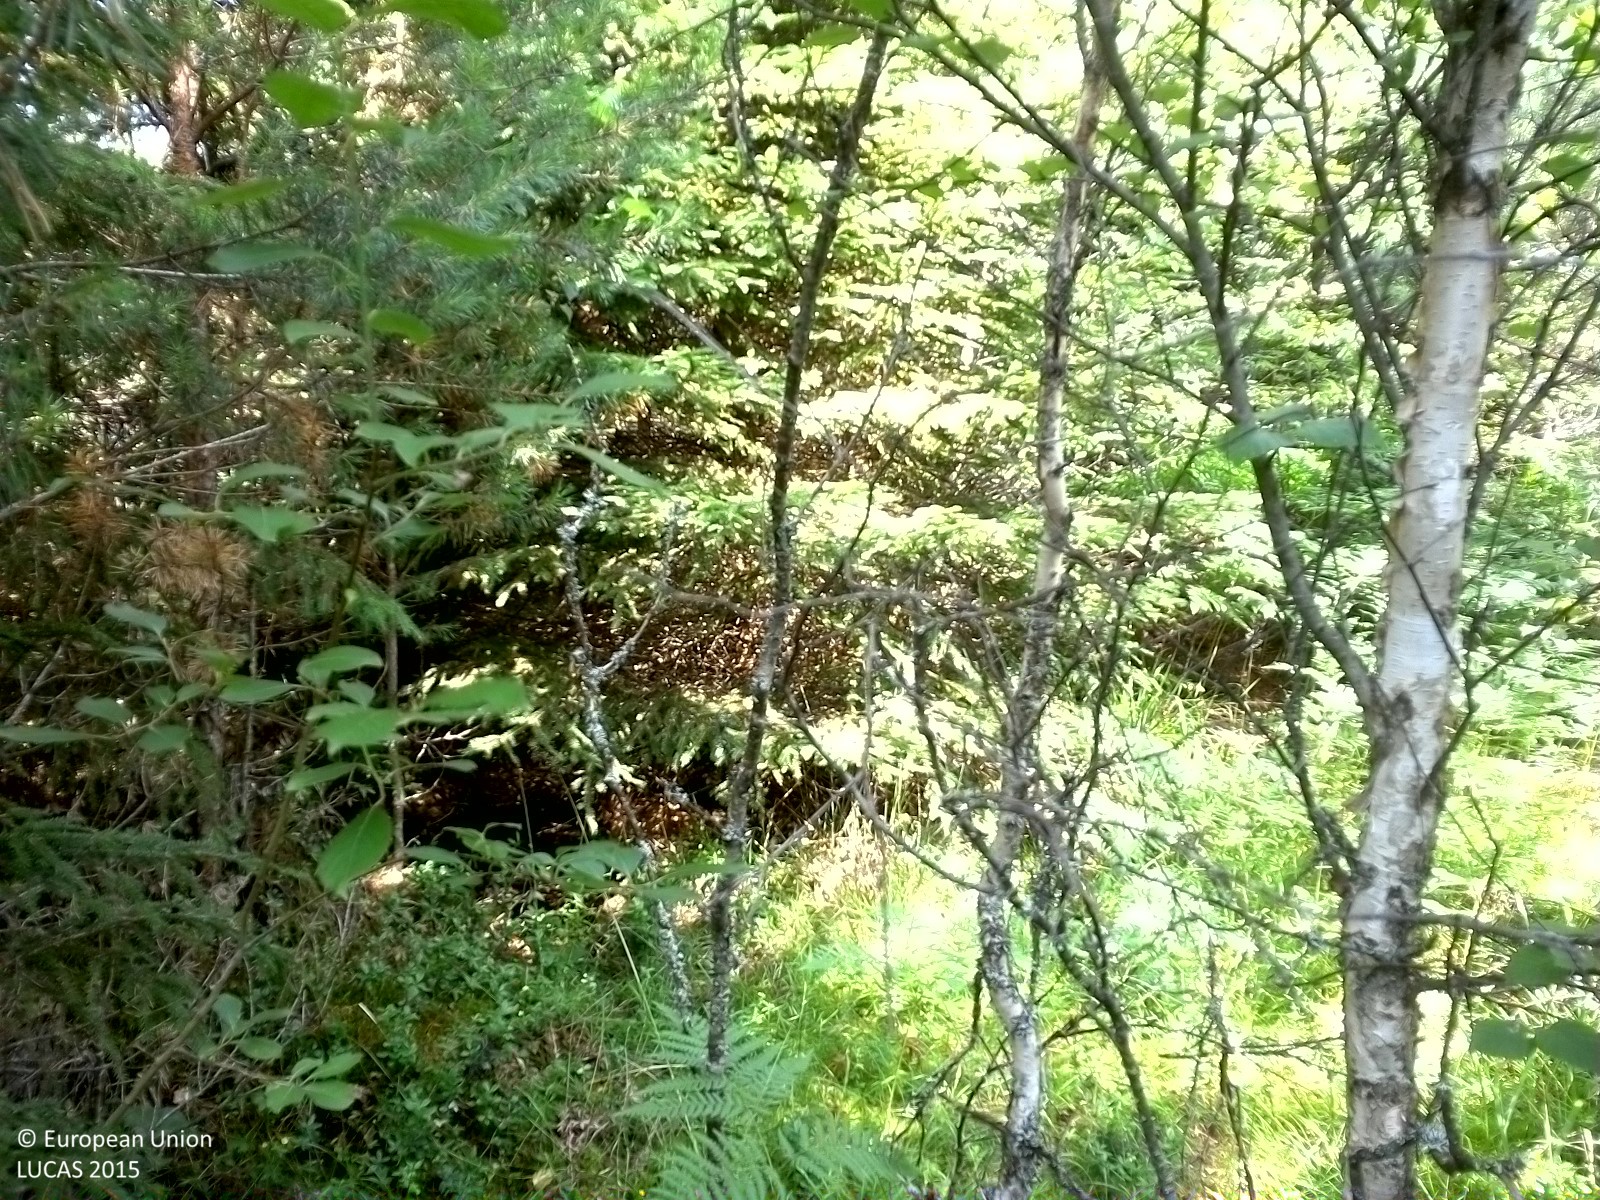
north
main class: Woodland
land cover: Other mixed woodland
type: boreal forest
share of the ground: > 75 %
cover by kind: coniferous forest trees 45 %, broadleaved forest trees 35 %, herbaceous plants 20 %
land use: Forestry
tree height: < 5 m
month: August
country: SE
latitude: 58.8691
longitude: 15.3862
